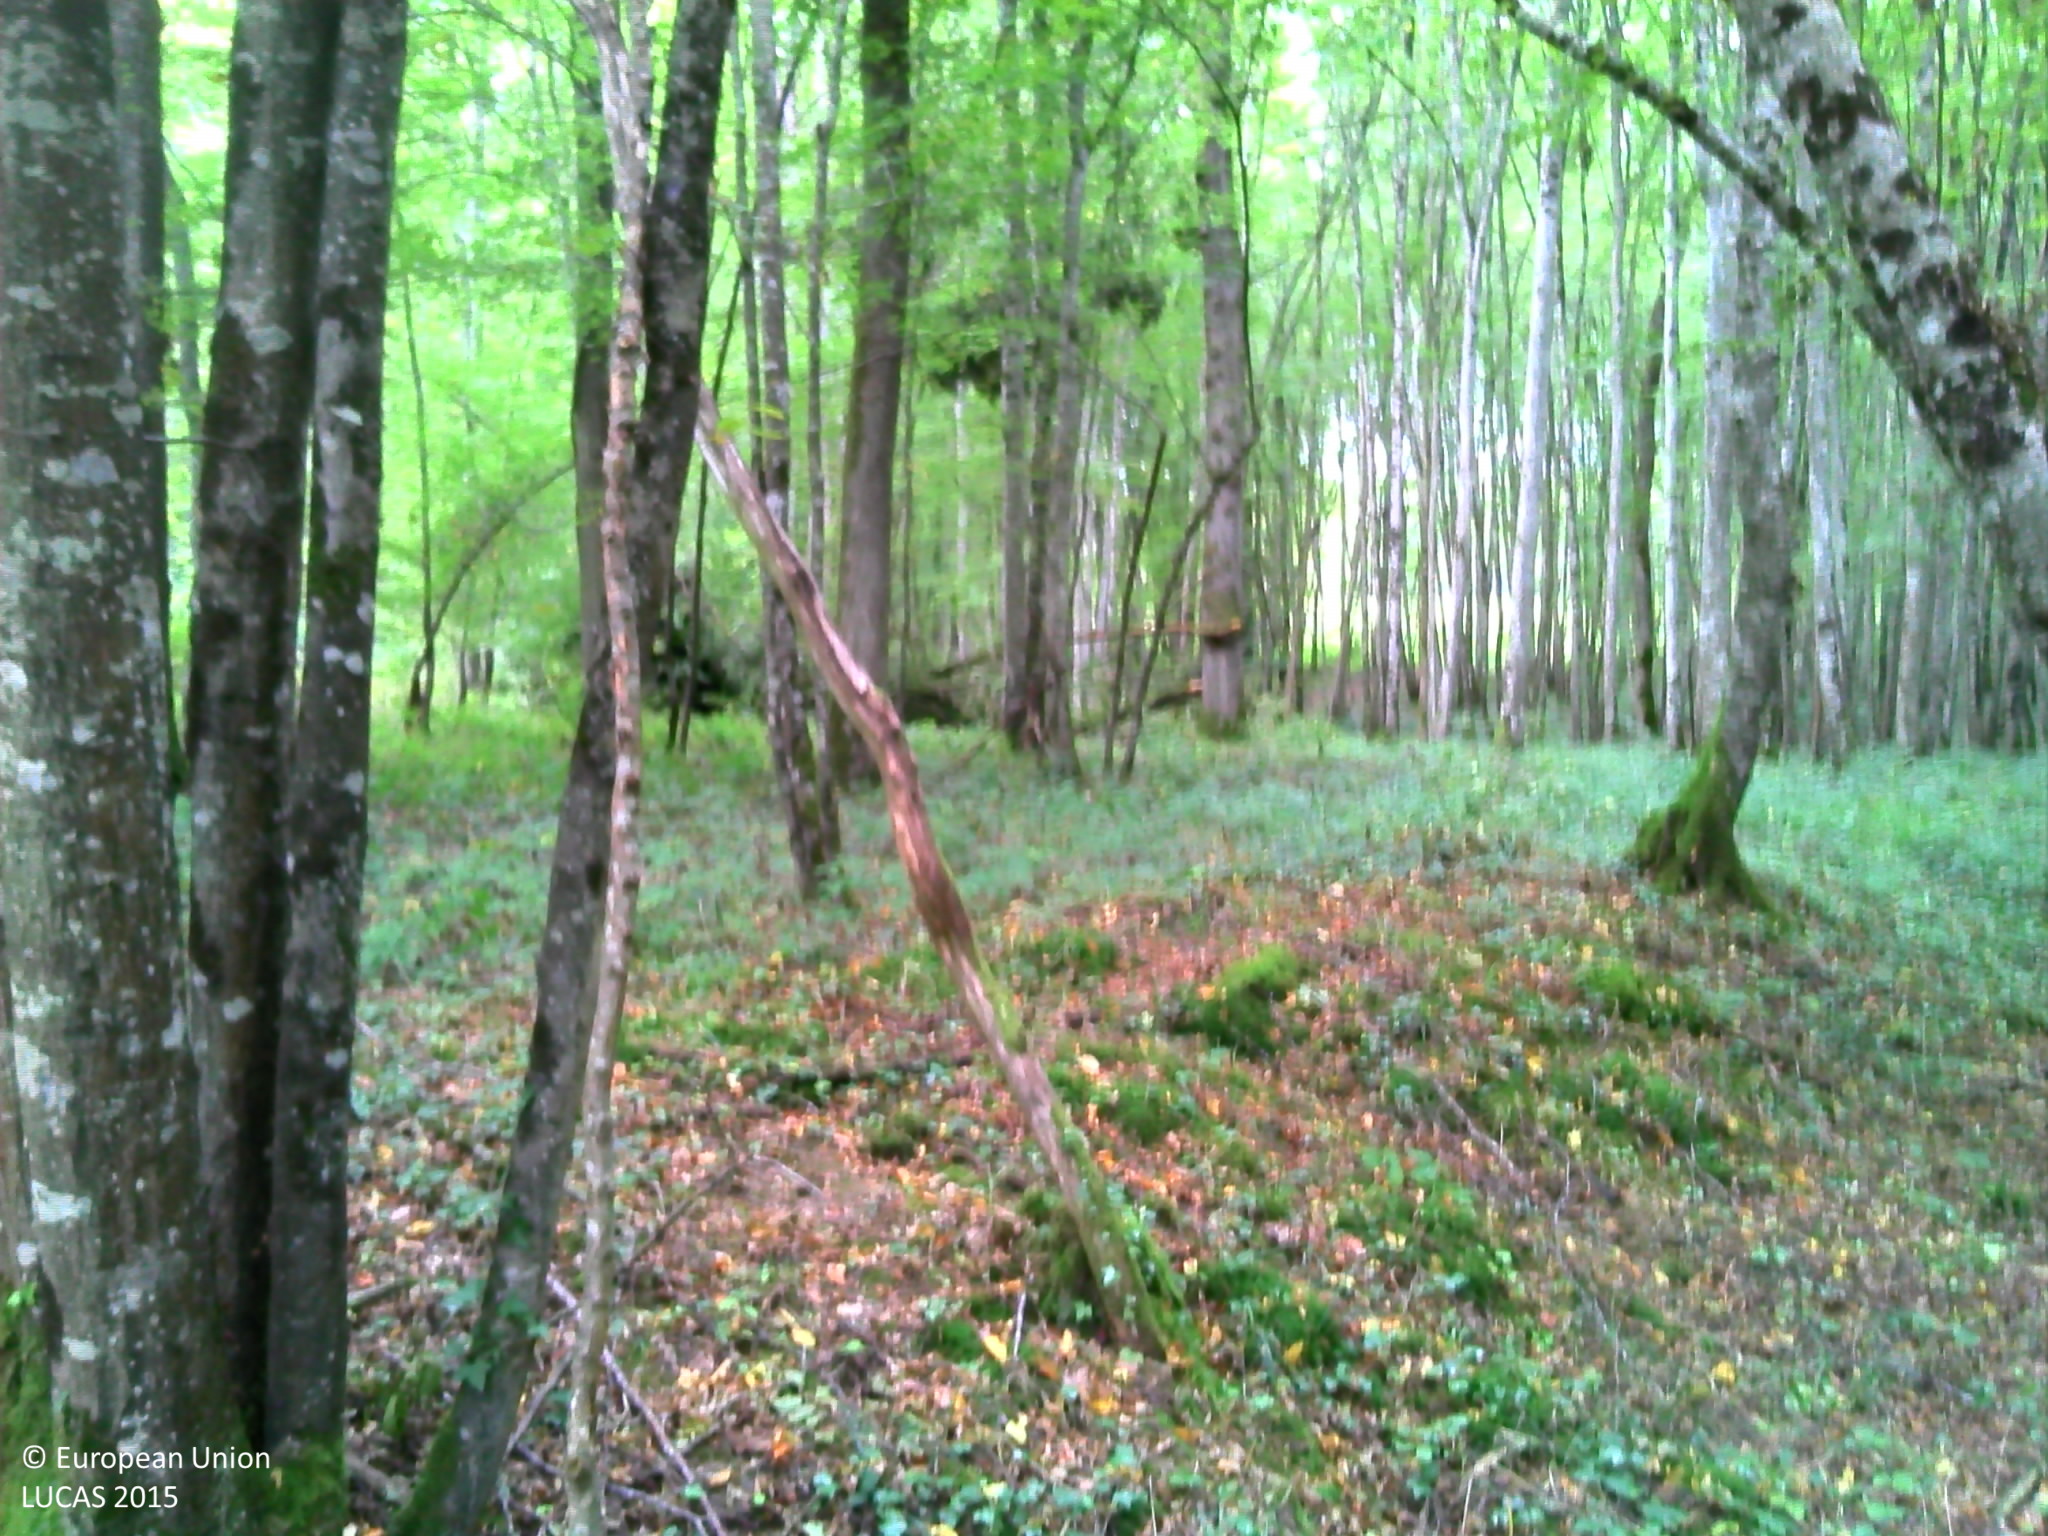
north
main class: Woodland
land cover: Broadleaved woodland
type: beech forest
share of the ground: > 75 %
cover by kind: broadleaved forest trees 90 %, herbaceous plants 10 %
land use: Forestry
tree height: > 5 m
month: September
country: FR
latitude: 47.0863
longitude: 5.0878
